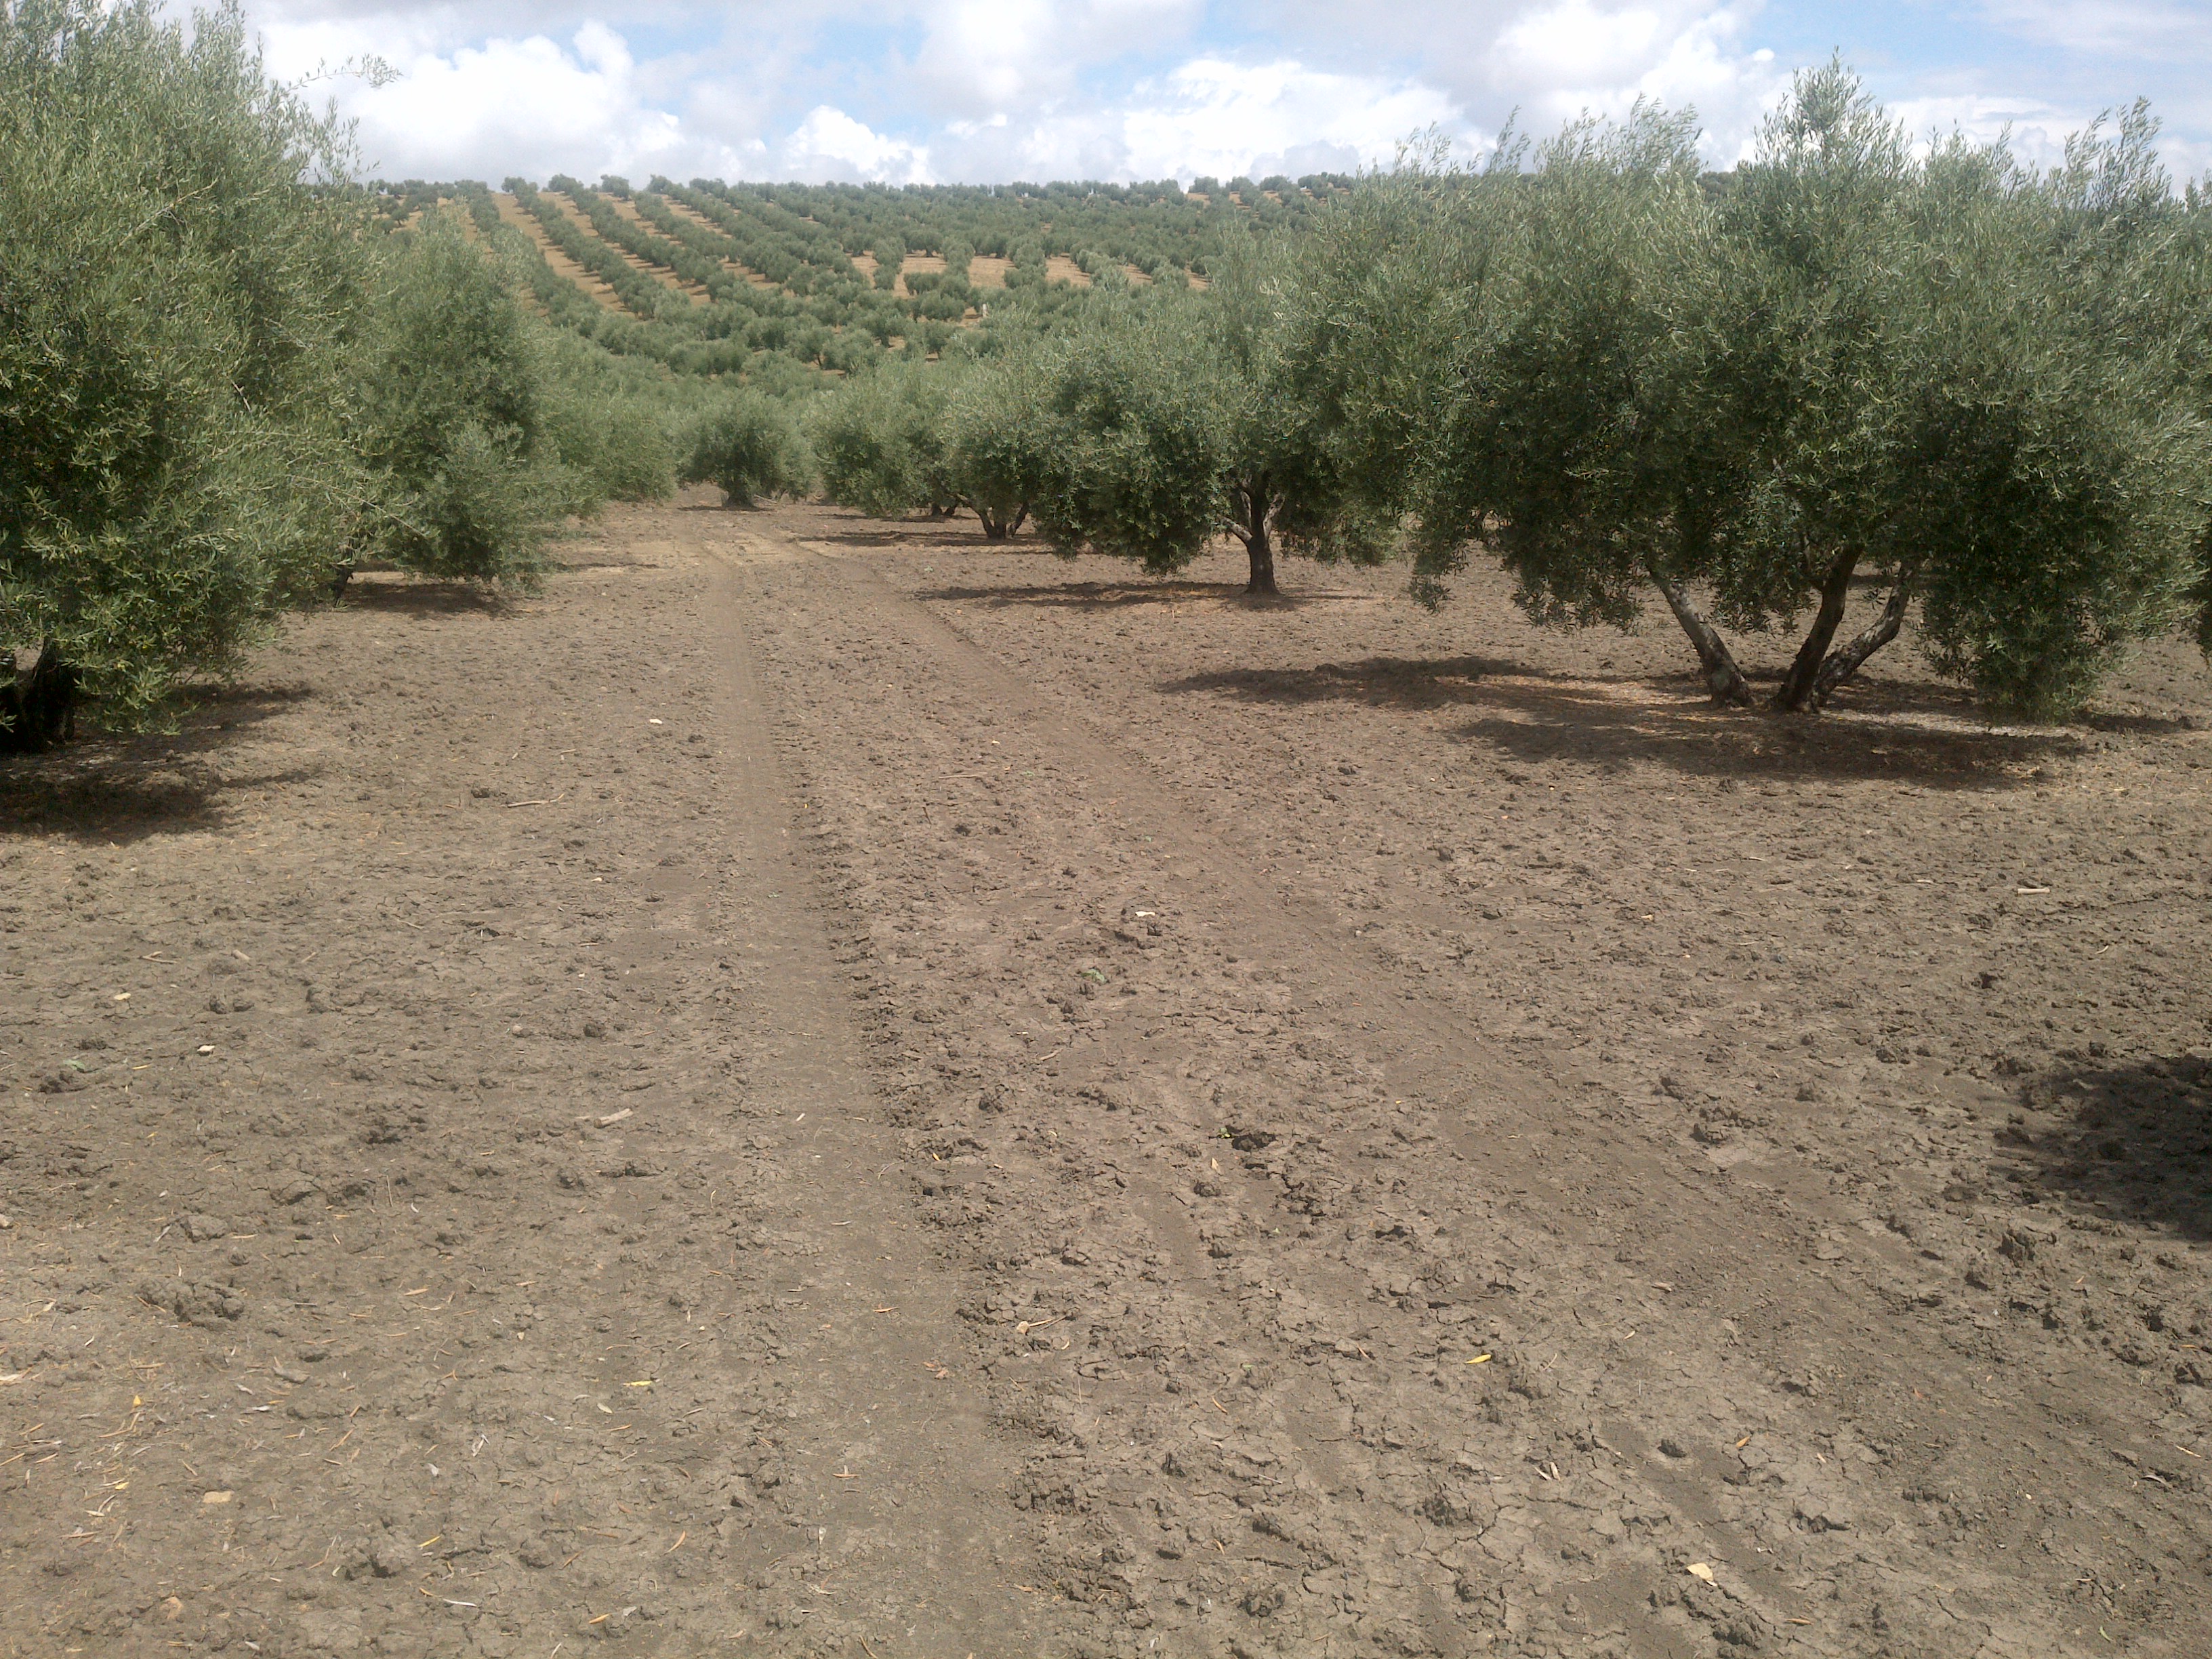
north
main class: Cropland
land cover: Olive groves
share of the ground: 50 - 75 %
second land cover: Other bare soil
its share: > 75 %
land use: Agriculture (excluding fallow land and kitchen gardens)
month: June
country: ES
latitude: 37.8596
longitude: -4.2722
